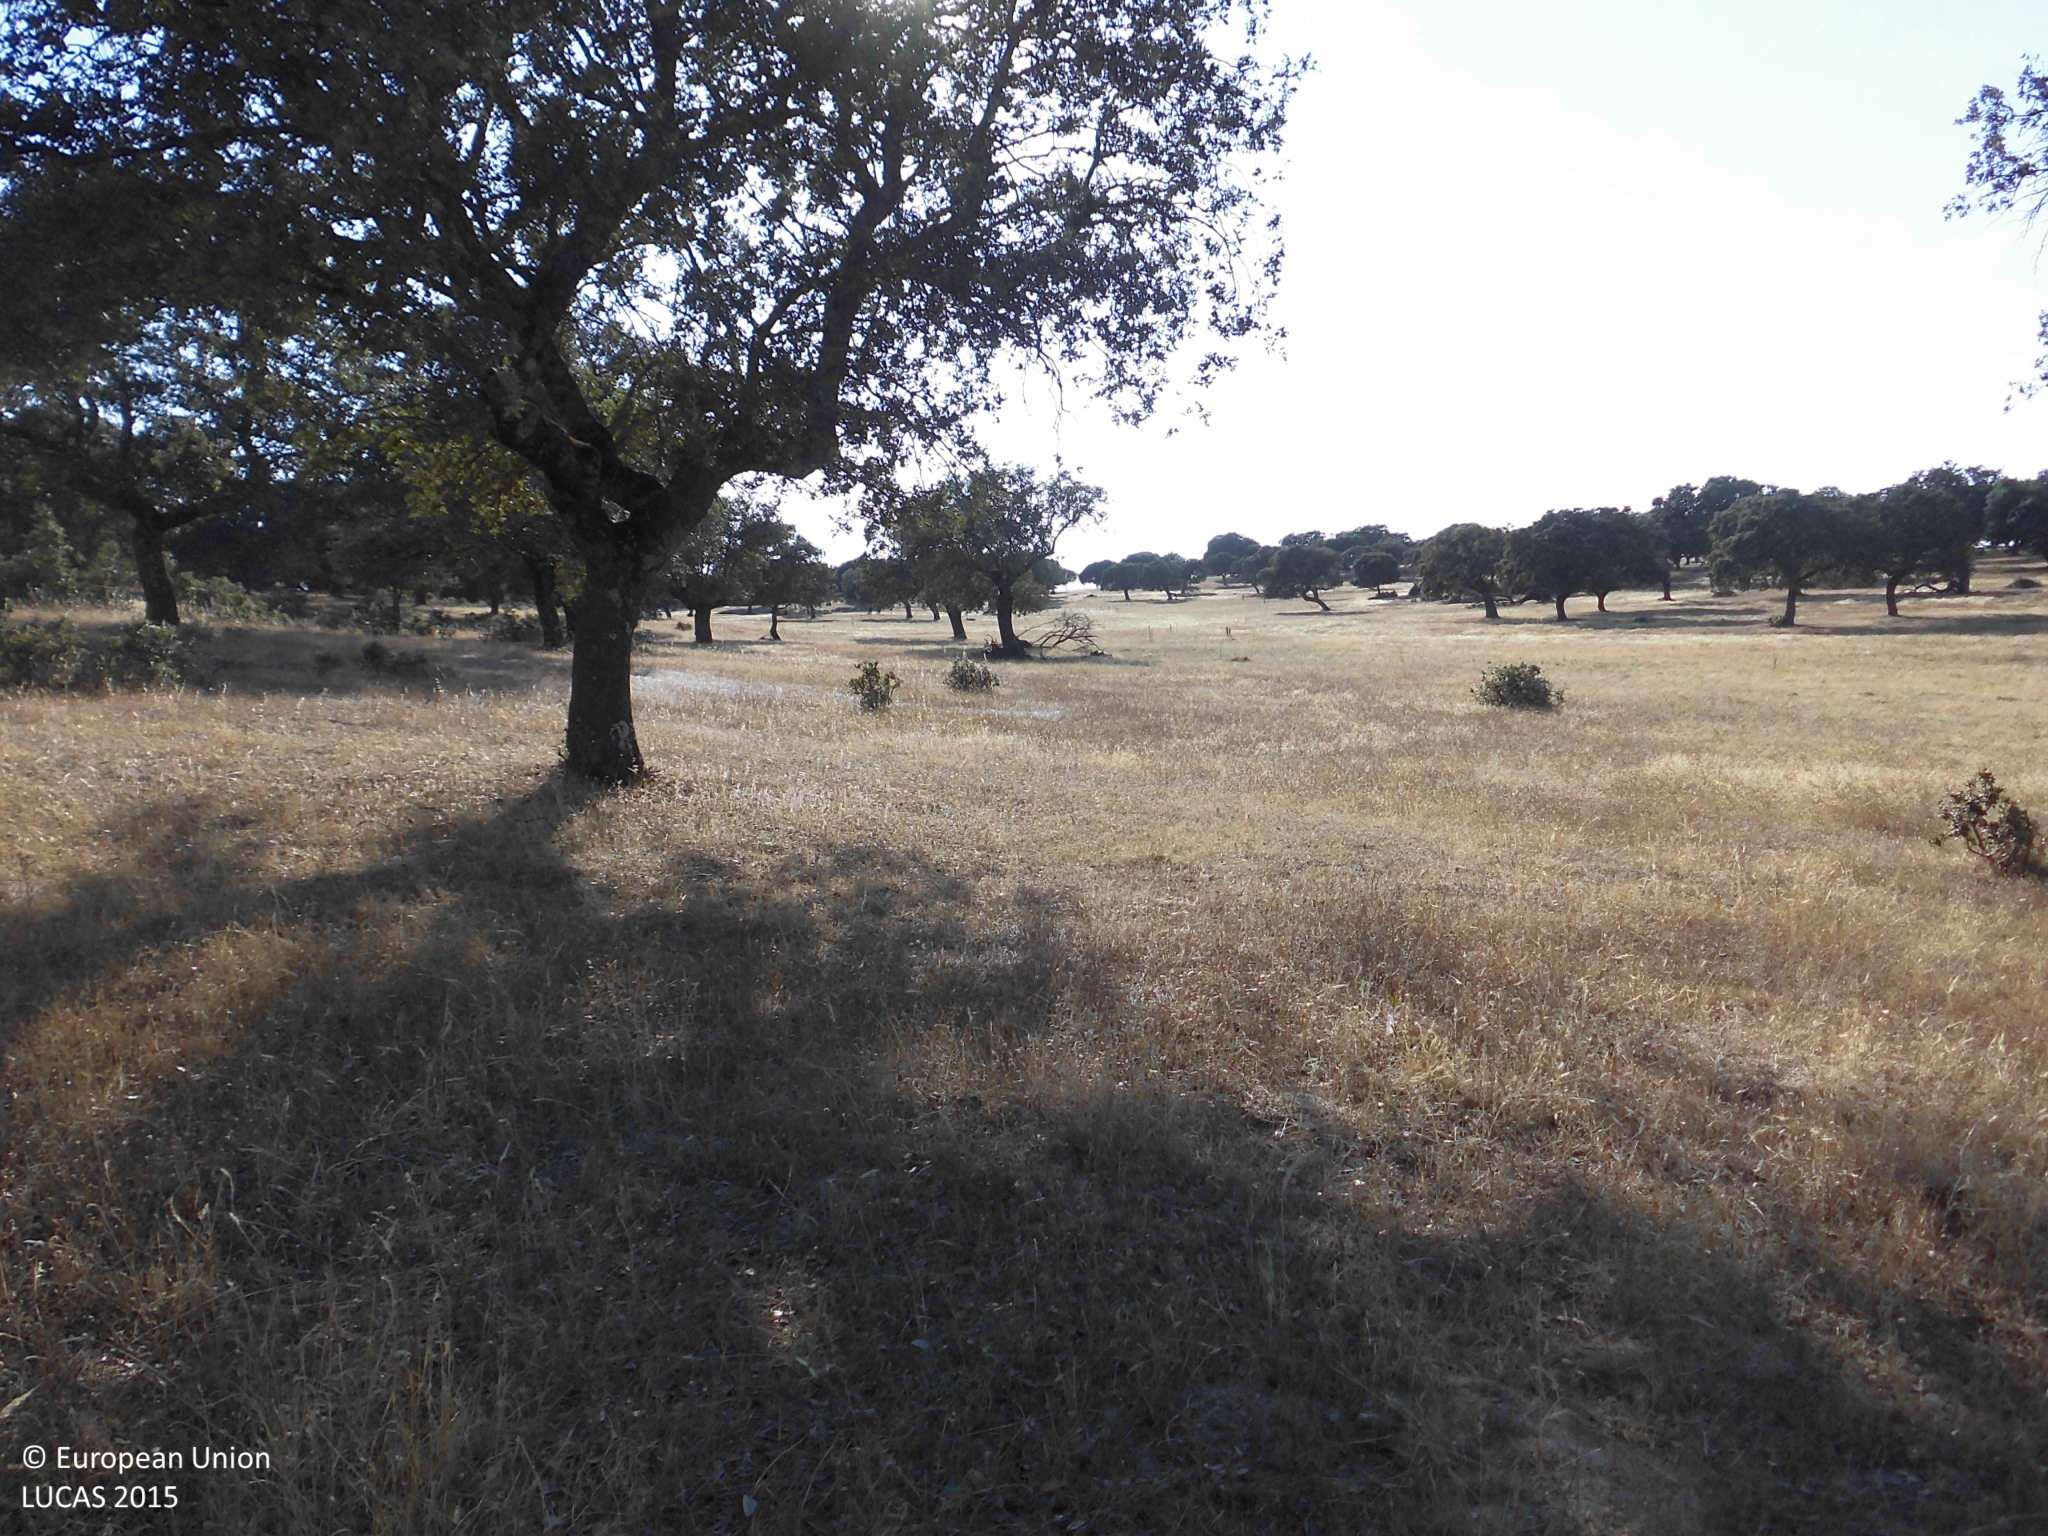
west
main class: Woodland
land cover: Broadleaved woodland
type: broadleaved evergreen forest
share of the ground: 25 - 50 %
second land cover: Grassland without tree/shrub cover
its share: > 75 %
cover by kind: herbaceous plants 75 %, broadleaved forest trees 25 %
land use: Forestry
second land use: Agriculture (excluding fallow land and kitchen gardens)
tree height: > 5 m
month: June
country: ES
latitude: 39.9161
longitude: -6.1332
